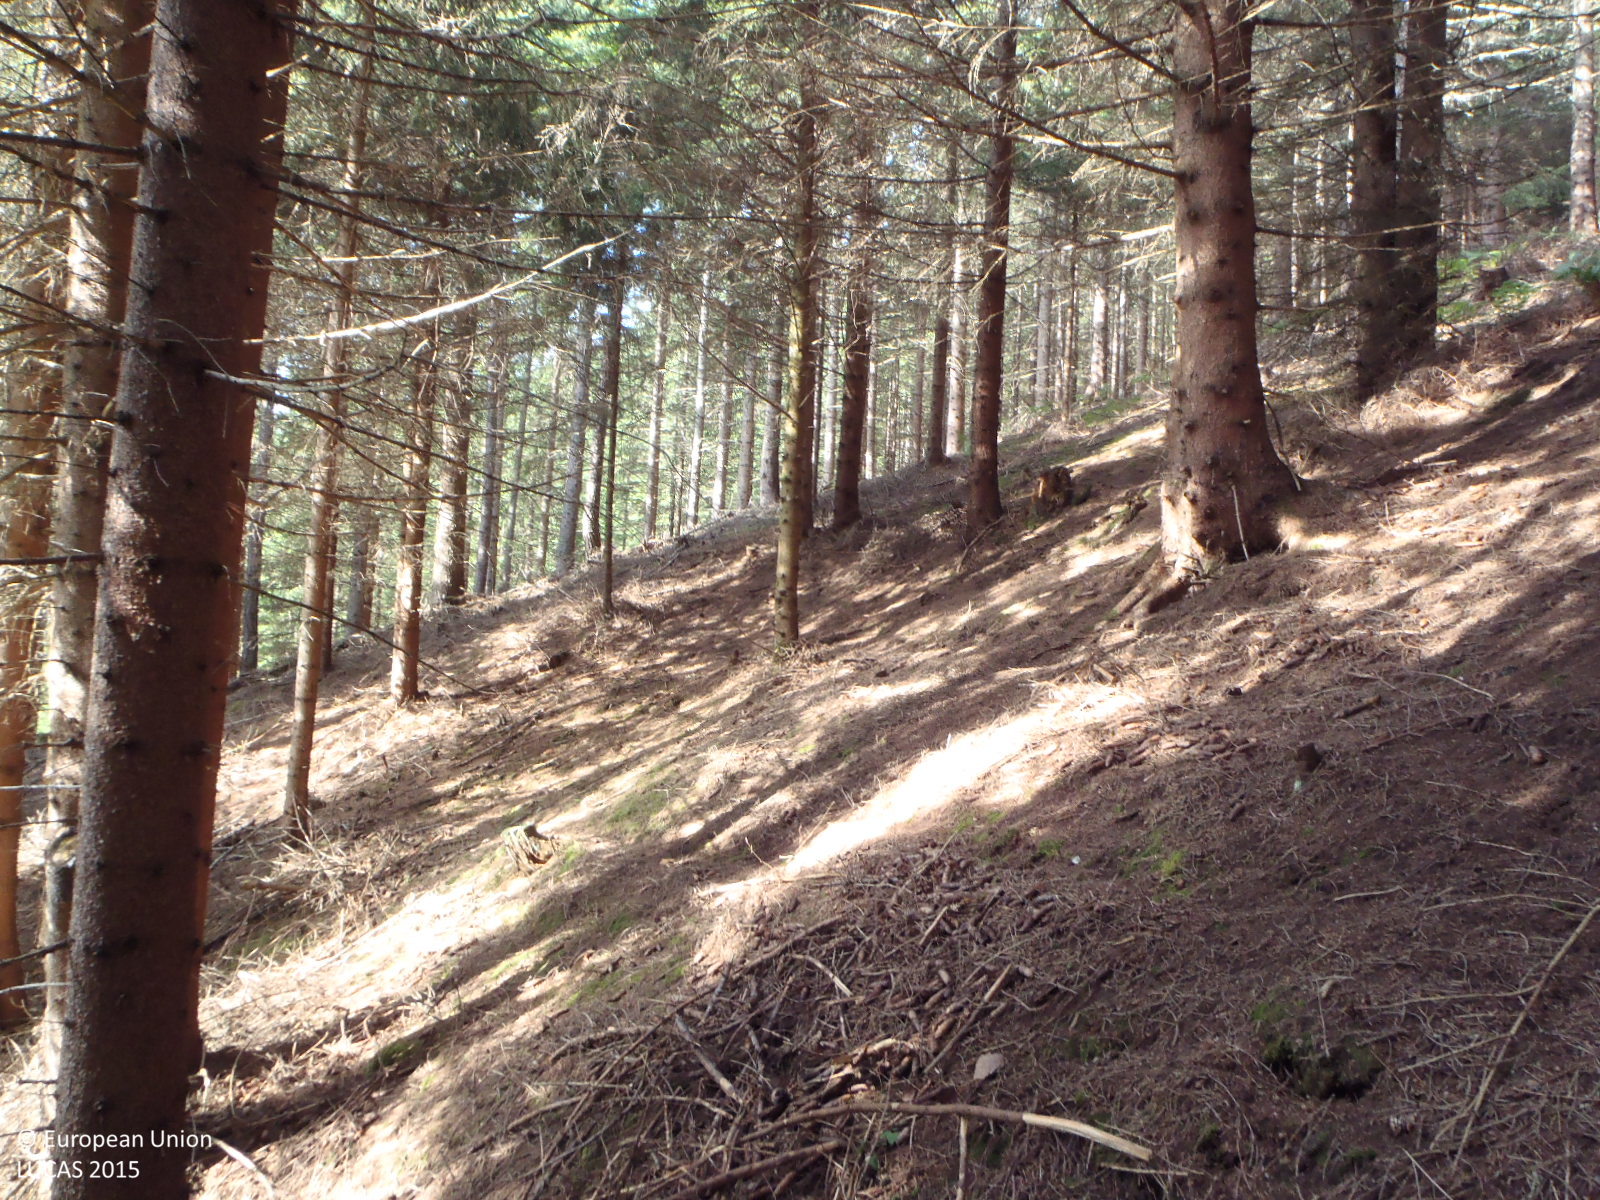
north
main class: Woodland
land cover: Spruce dominated coniferous woodland
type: alpine coniferous forest
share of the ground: > 75 %
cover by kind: coniferous forest trees 90 %, lichens and mosses 5 %, unconsolidated bare surface 5 %
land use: Forestry
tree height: > 5 m
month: August
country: AT
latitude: 47.1164
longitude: 13.7014
